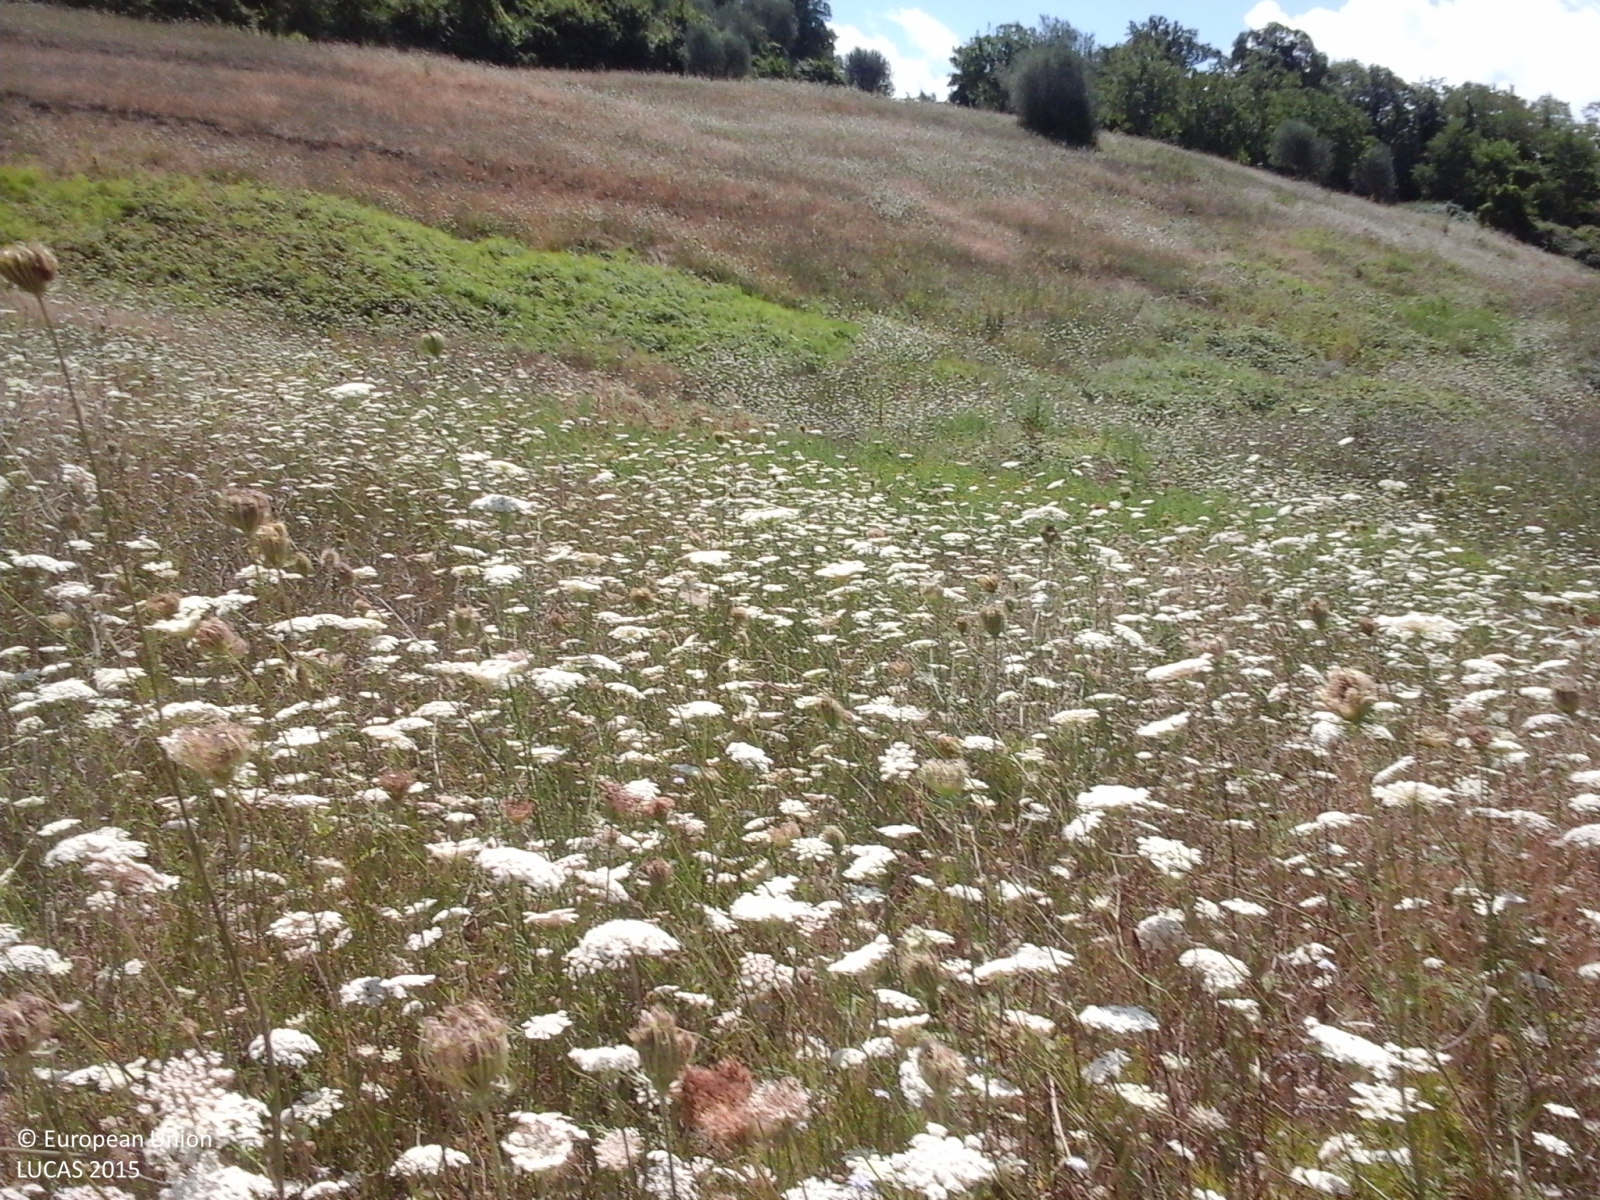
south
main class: Grassland
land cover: Grassland without tree/shrub cover
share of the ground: > 75 %
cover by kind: herbaceous plants 100 %
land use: Agriculture (excluding fallow land and kitchen gardens)
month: August
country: IT
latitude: 43.1838
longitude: 11.5579
